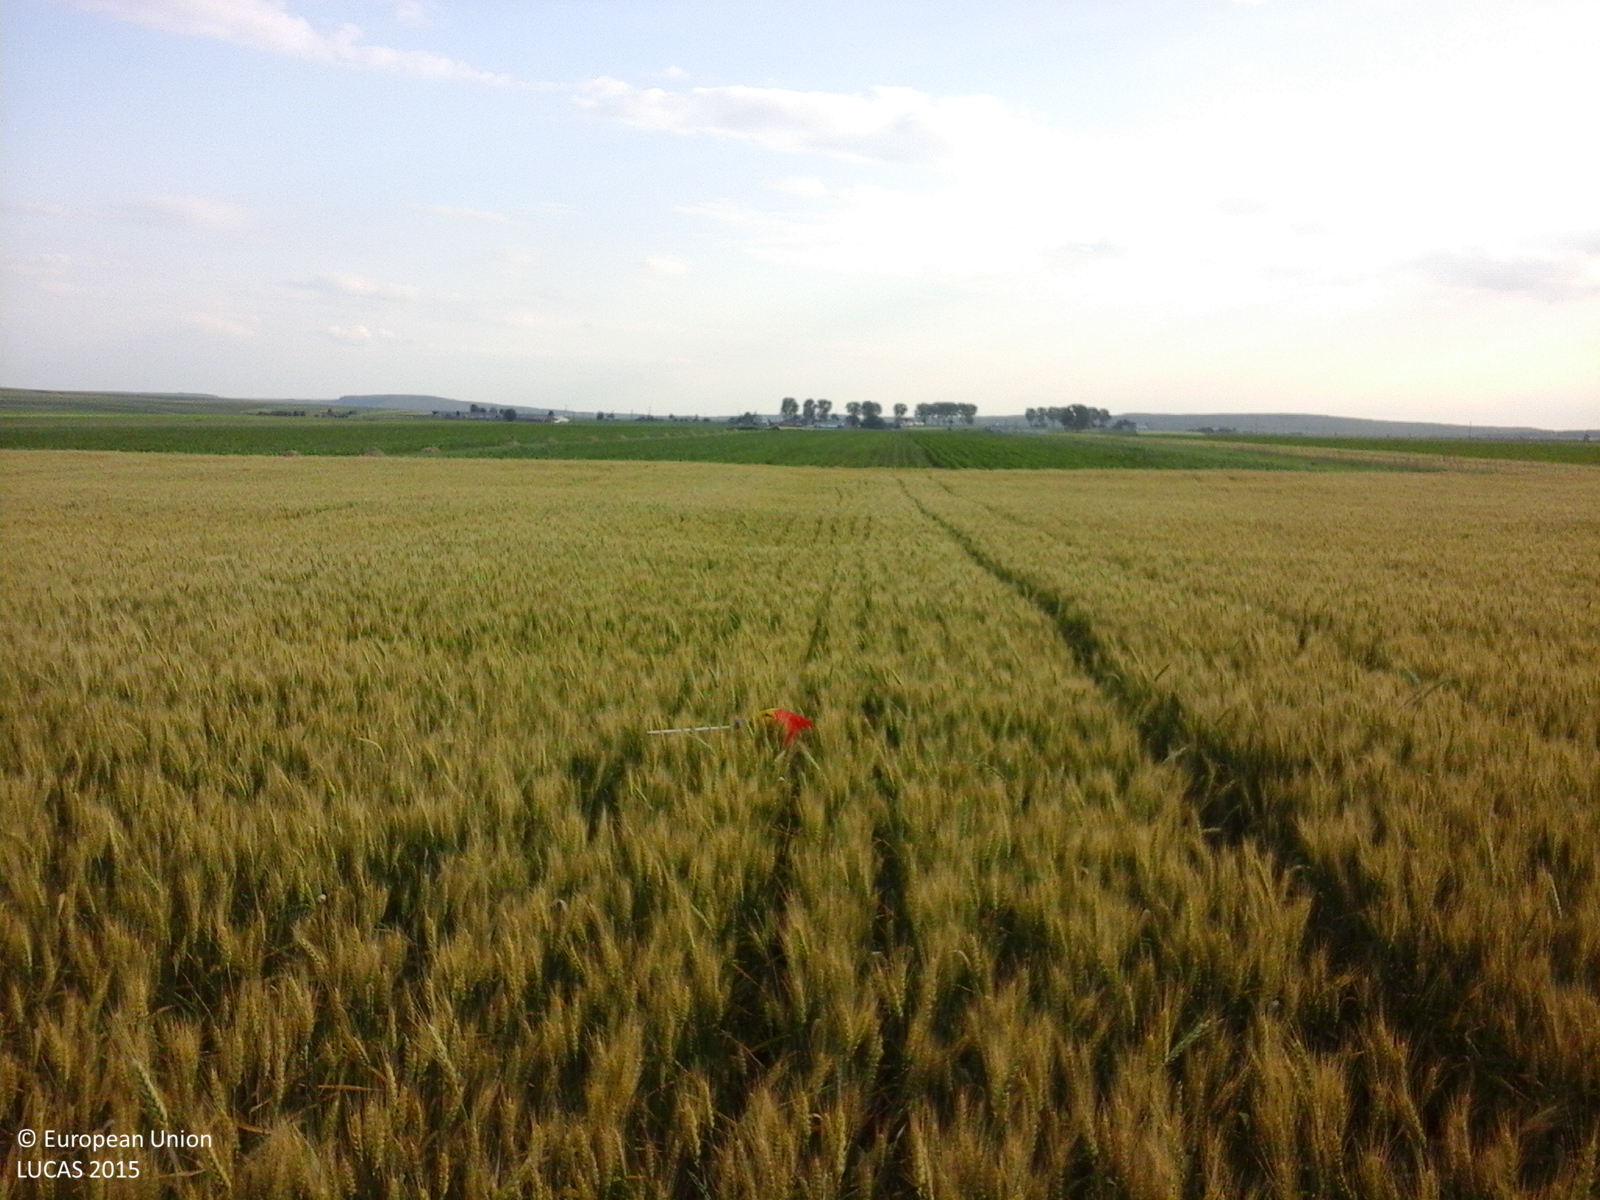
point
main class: Cropland
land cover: Common wheat
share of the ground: > 75 %
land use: Agriculture (excluding fallow land and kitchen gardens)
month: June
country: RO
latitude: 47.8058
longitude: 26.3091
